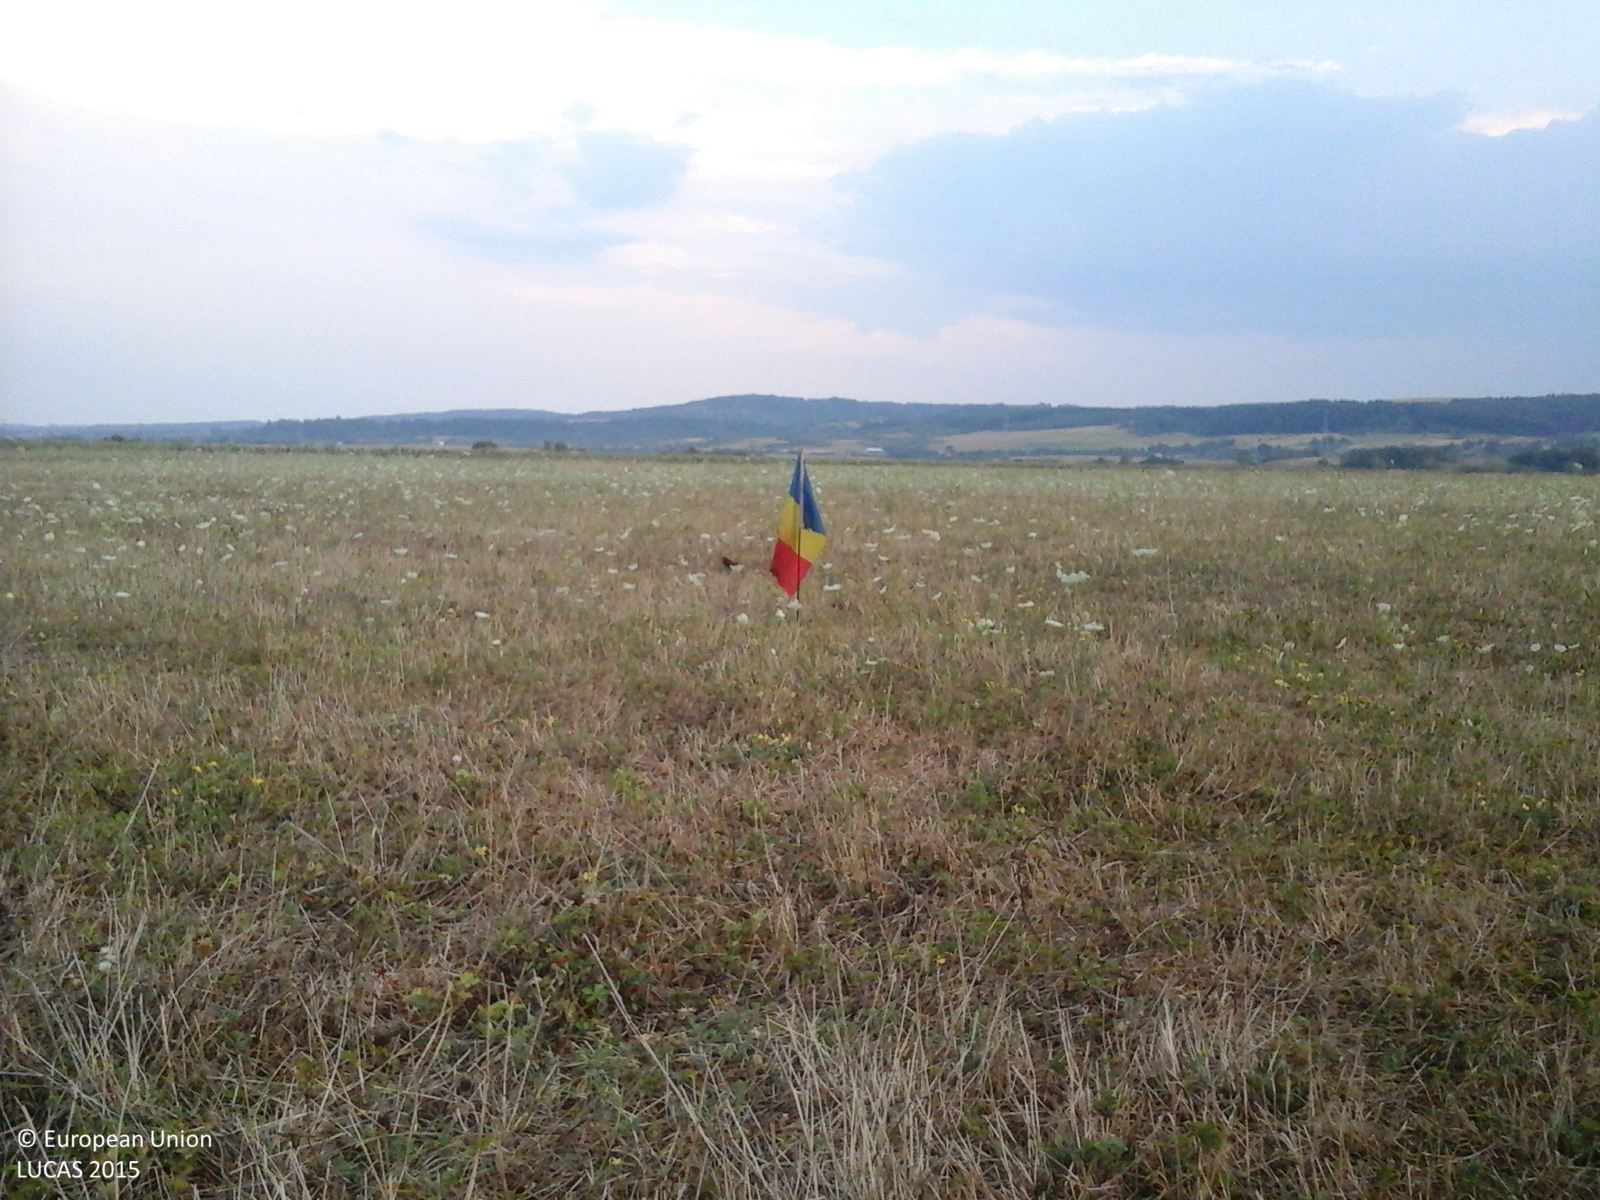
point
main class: Grassland
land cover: Grassland without tree/shrub cover
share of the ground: > 75 %
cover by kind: herbaceous plants 100 %
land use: Agriculture (excluding fallow land and kitchen gardens)
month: August
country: RO
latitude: 44.6801
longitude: 23.1316
